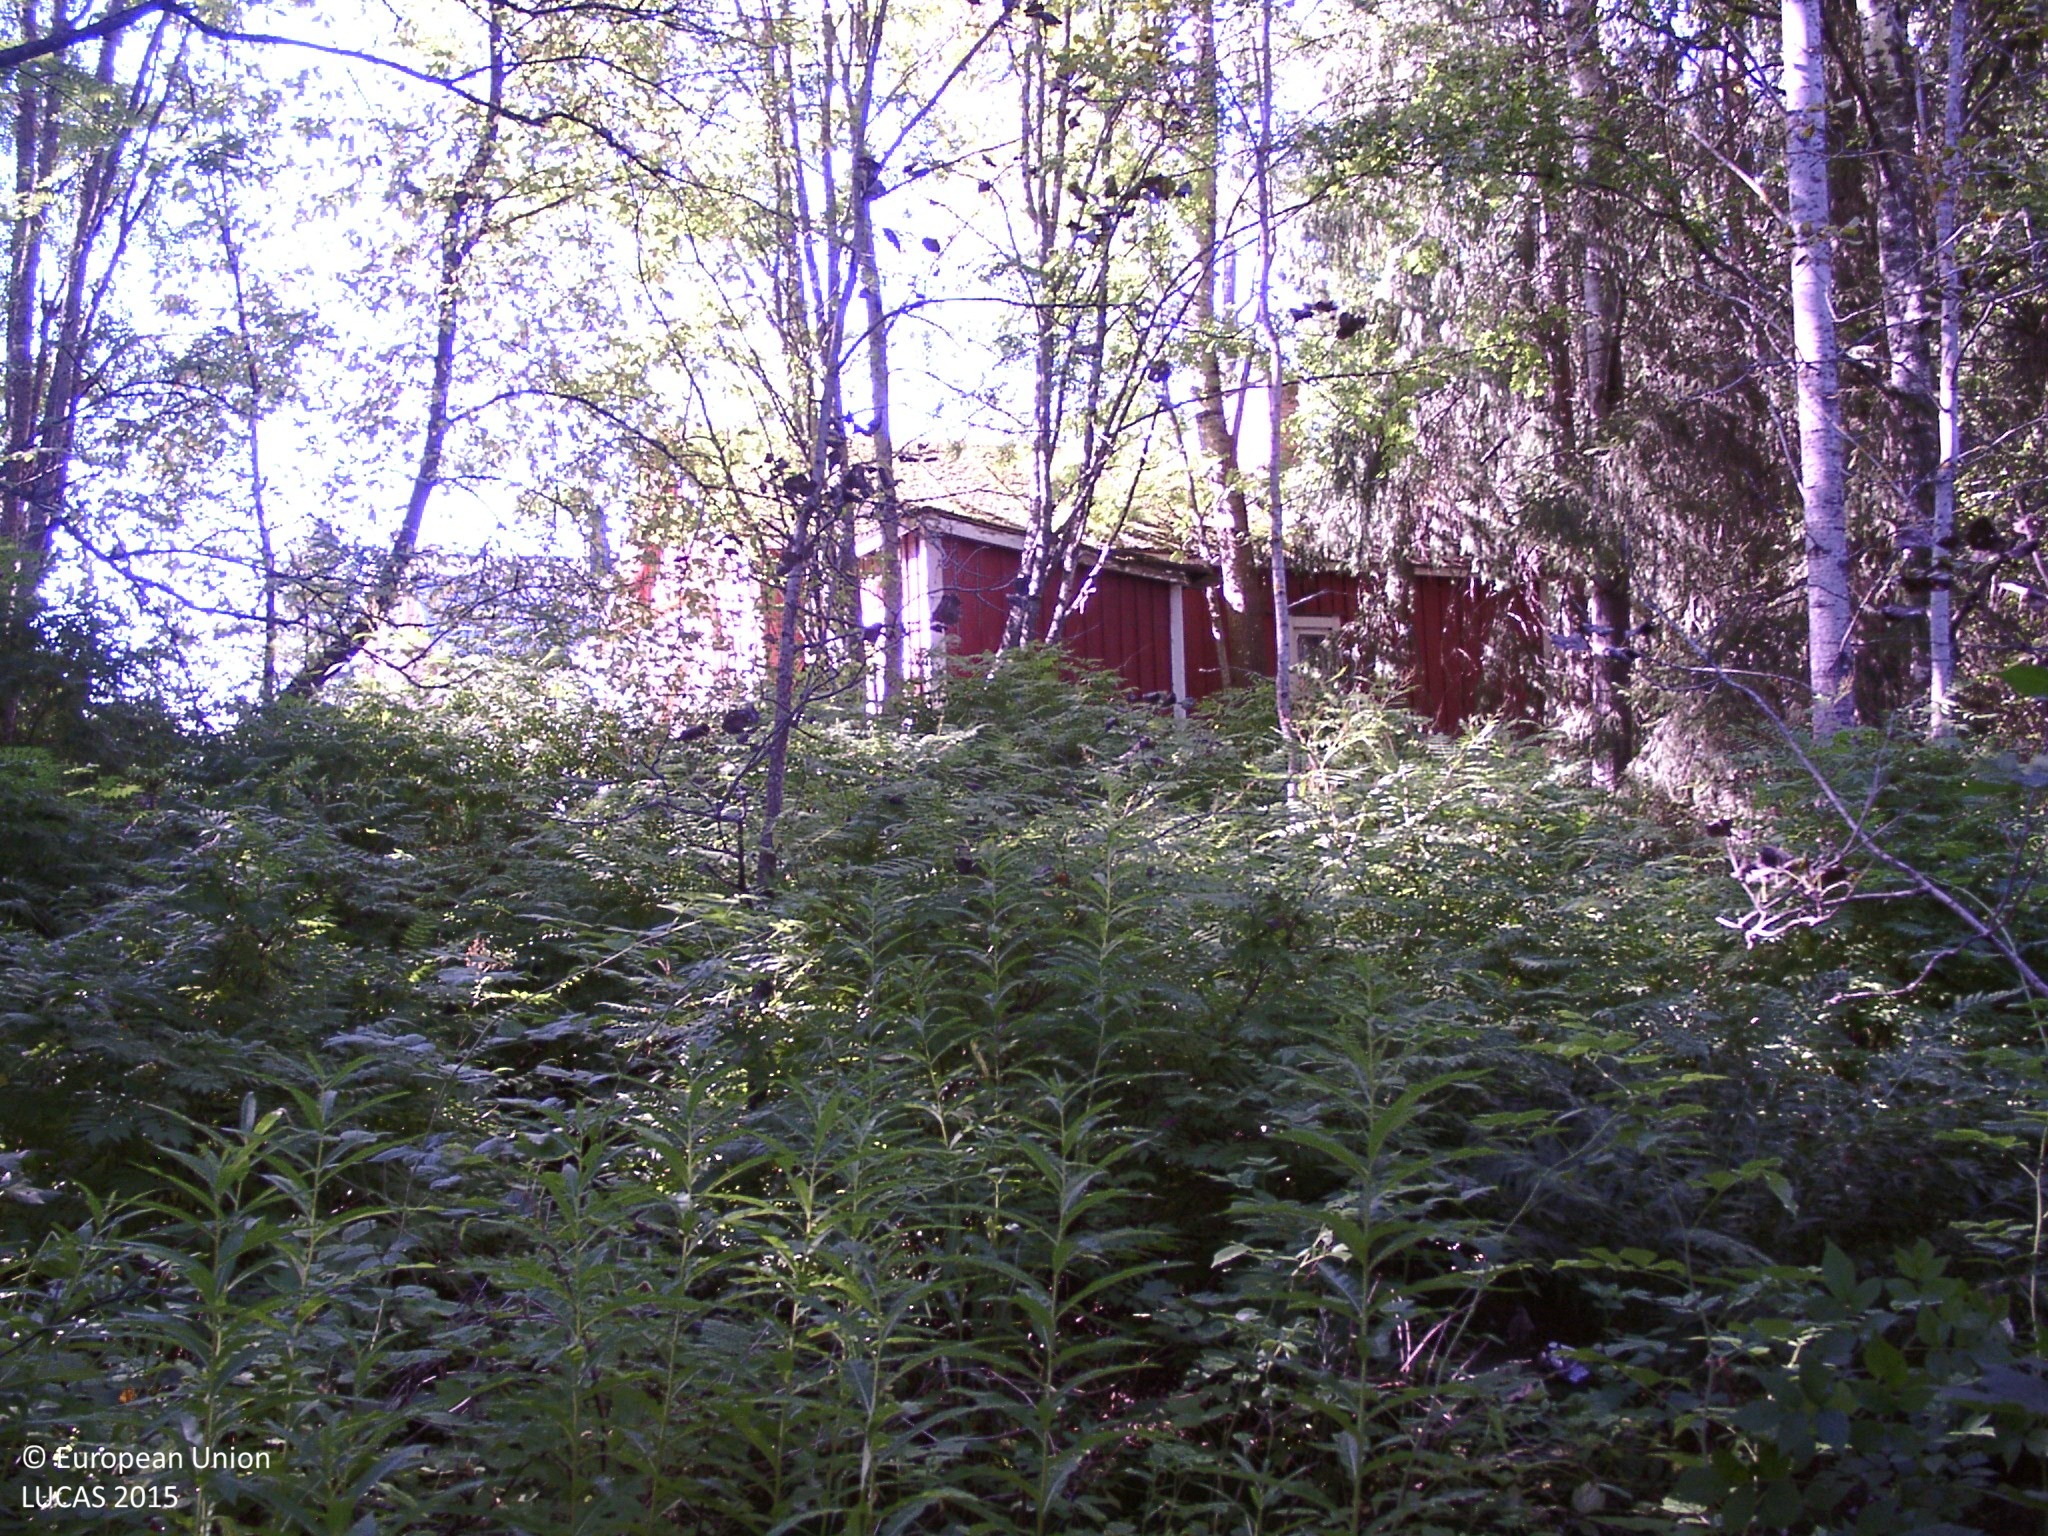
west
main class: Woodland
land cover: Broadleaved woodland
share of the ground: 50 - 75 %
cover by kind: broadleaved forest trees 50 %, shrubs 30 %, coniferous forest trees 15 %, herbaceous plants 5 %
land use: Semi-natural and natural areas not in use
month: August
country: FI
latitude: 61.8583
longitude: 25.1429
